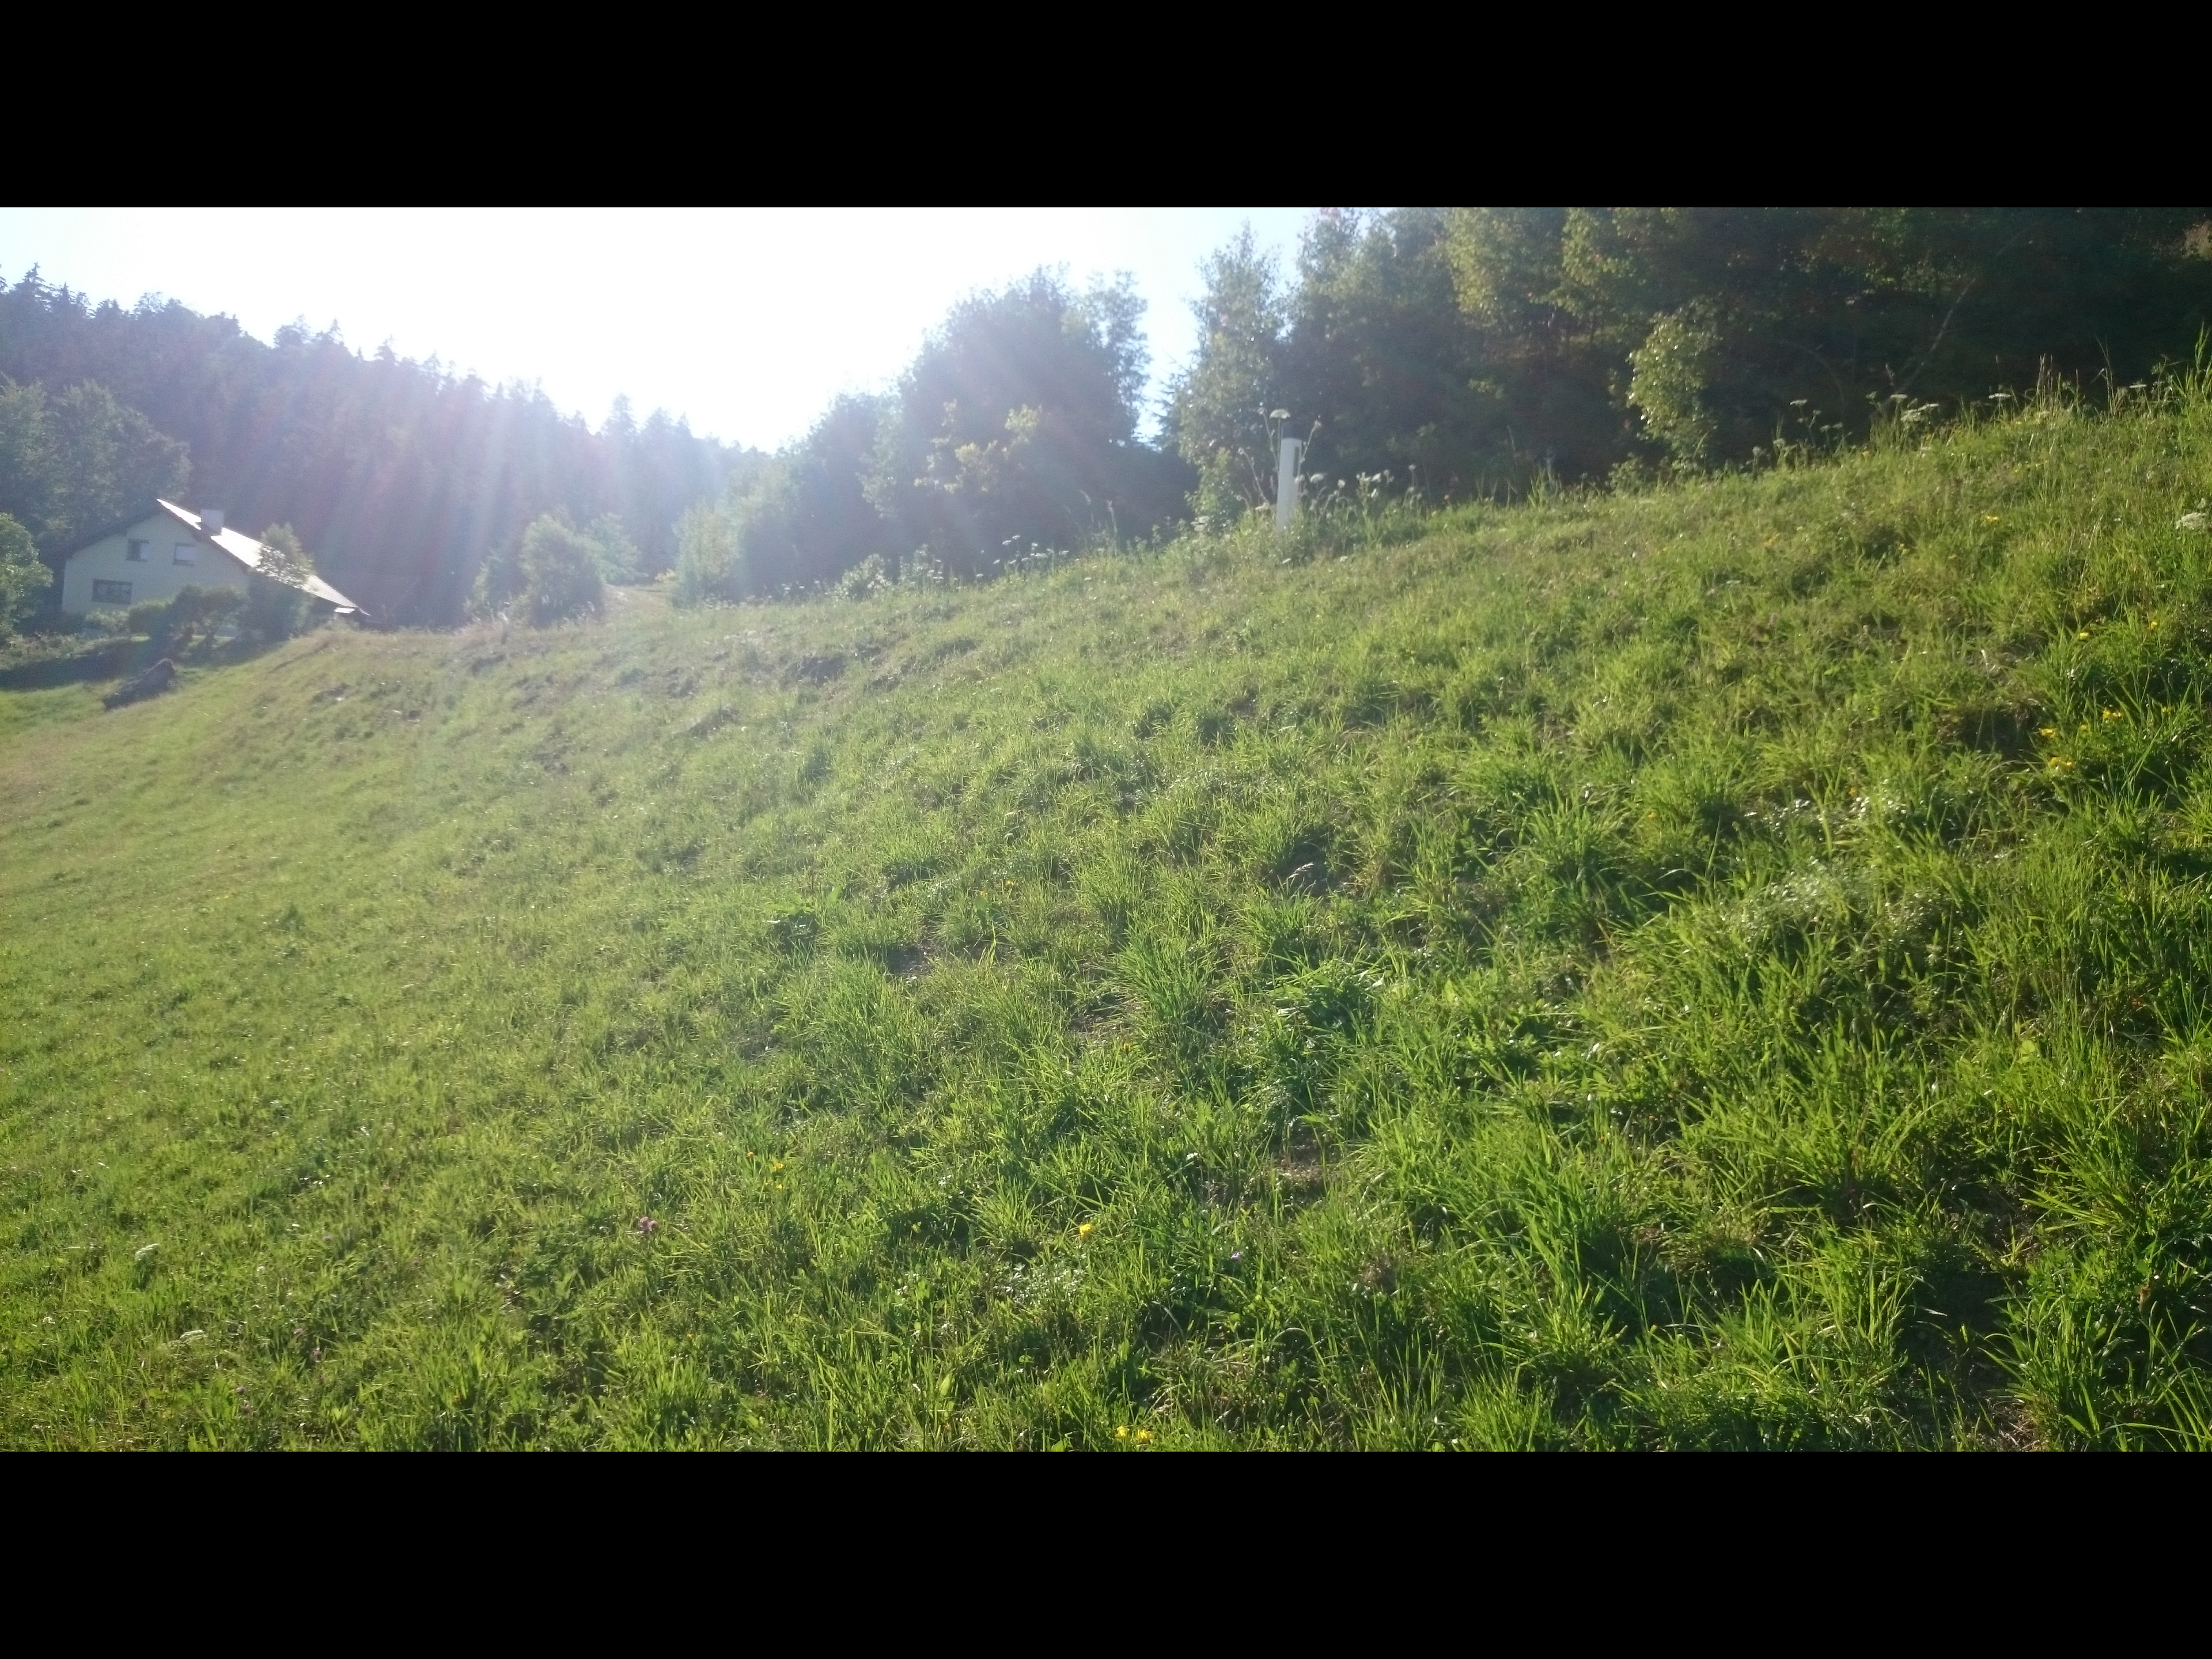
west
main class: Grassland
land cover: Grassland without tree/shrub cover
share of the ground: > 75 %
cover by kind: herbaceous plants 90 %, consolidated bare surface 5 %, unconsolidated bare surface 5 %
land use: Agriculture (excluding fallow land and kitchen gardens)
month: July
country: AT
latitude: 48.2891
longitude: 15.0286
